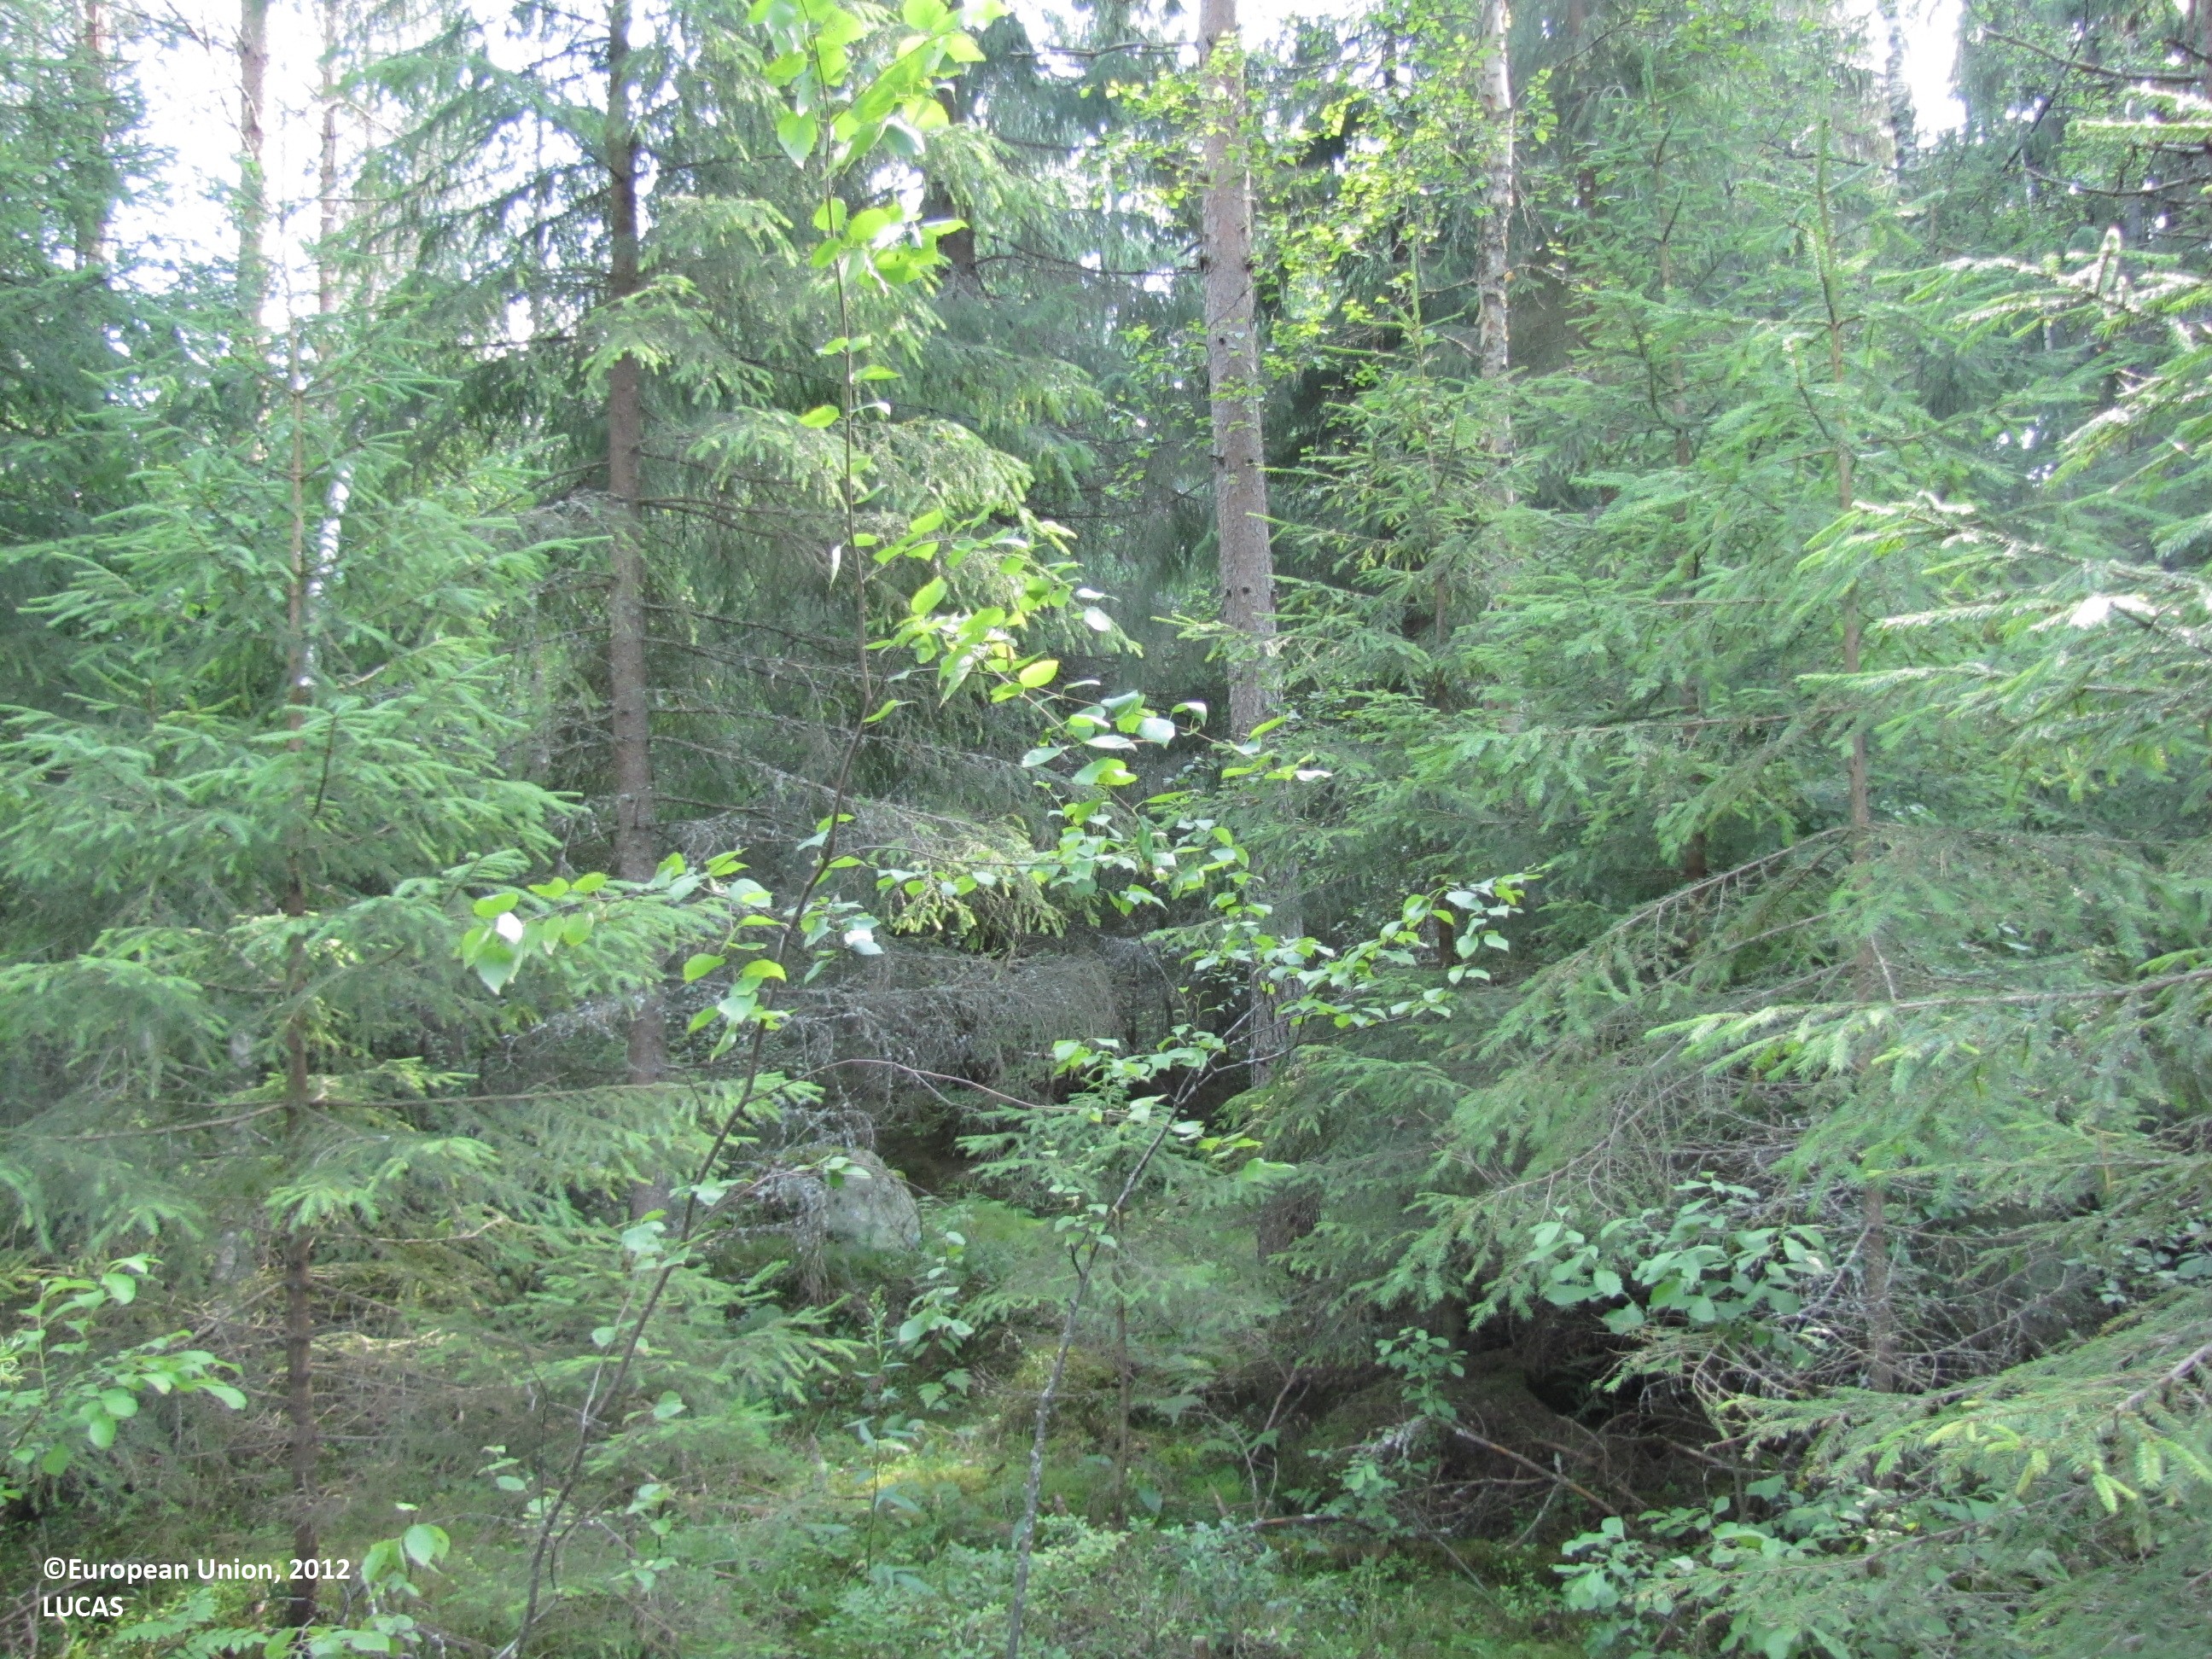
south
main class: Woodland
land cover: Other coniferous woodland
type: boreal forest
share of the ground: 50 - 75 %
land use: Forestry
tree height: > 5 m
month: July
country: FI
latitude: 62.1732
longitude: 23.4185
